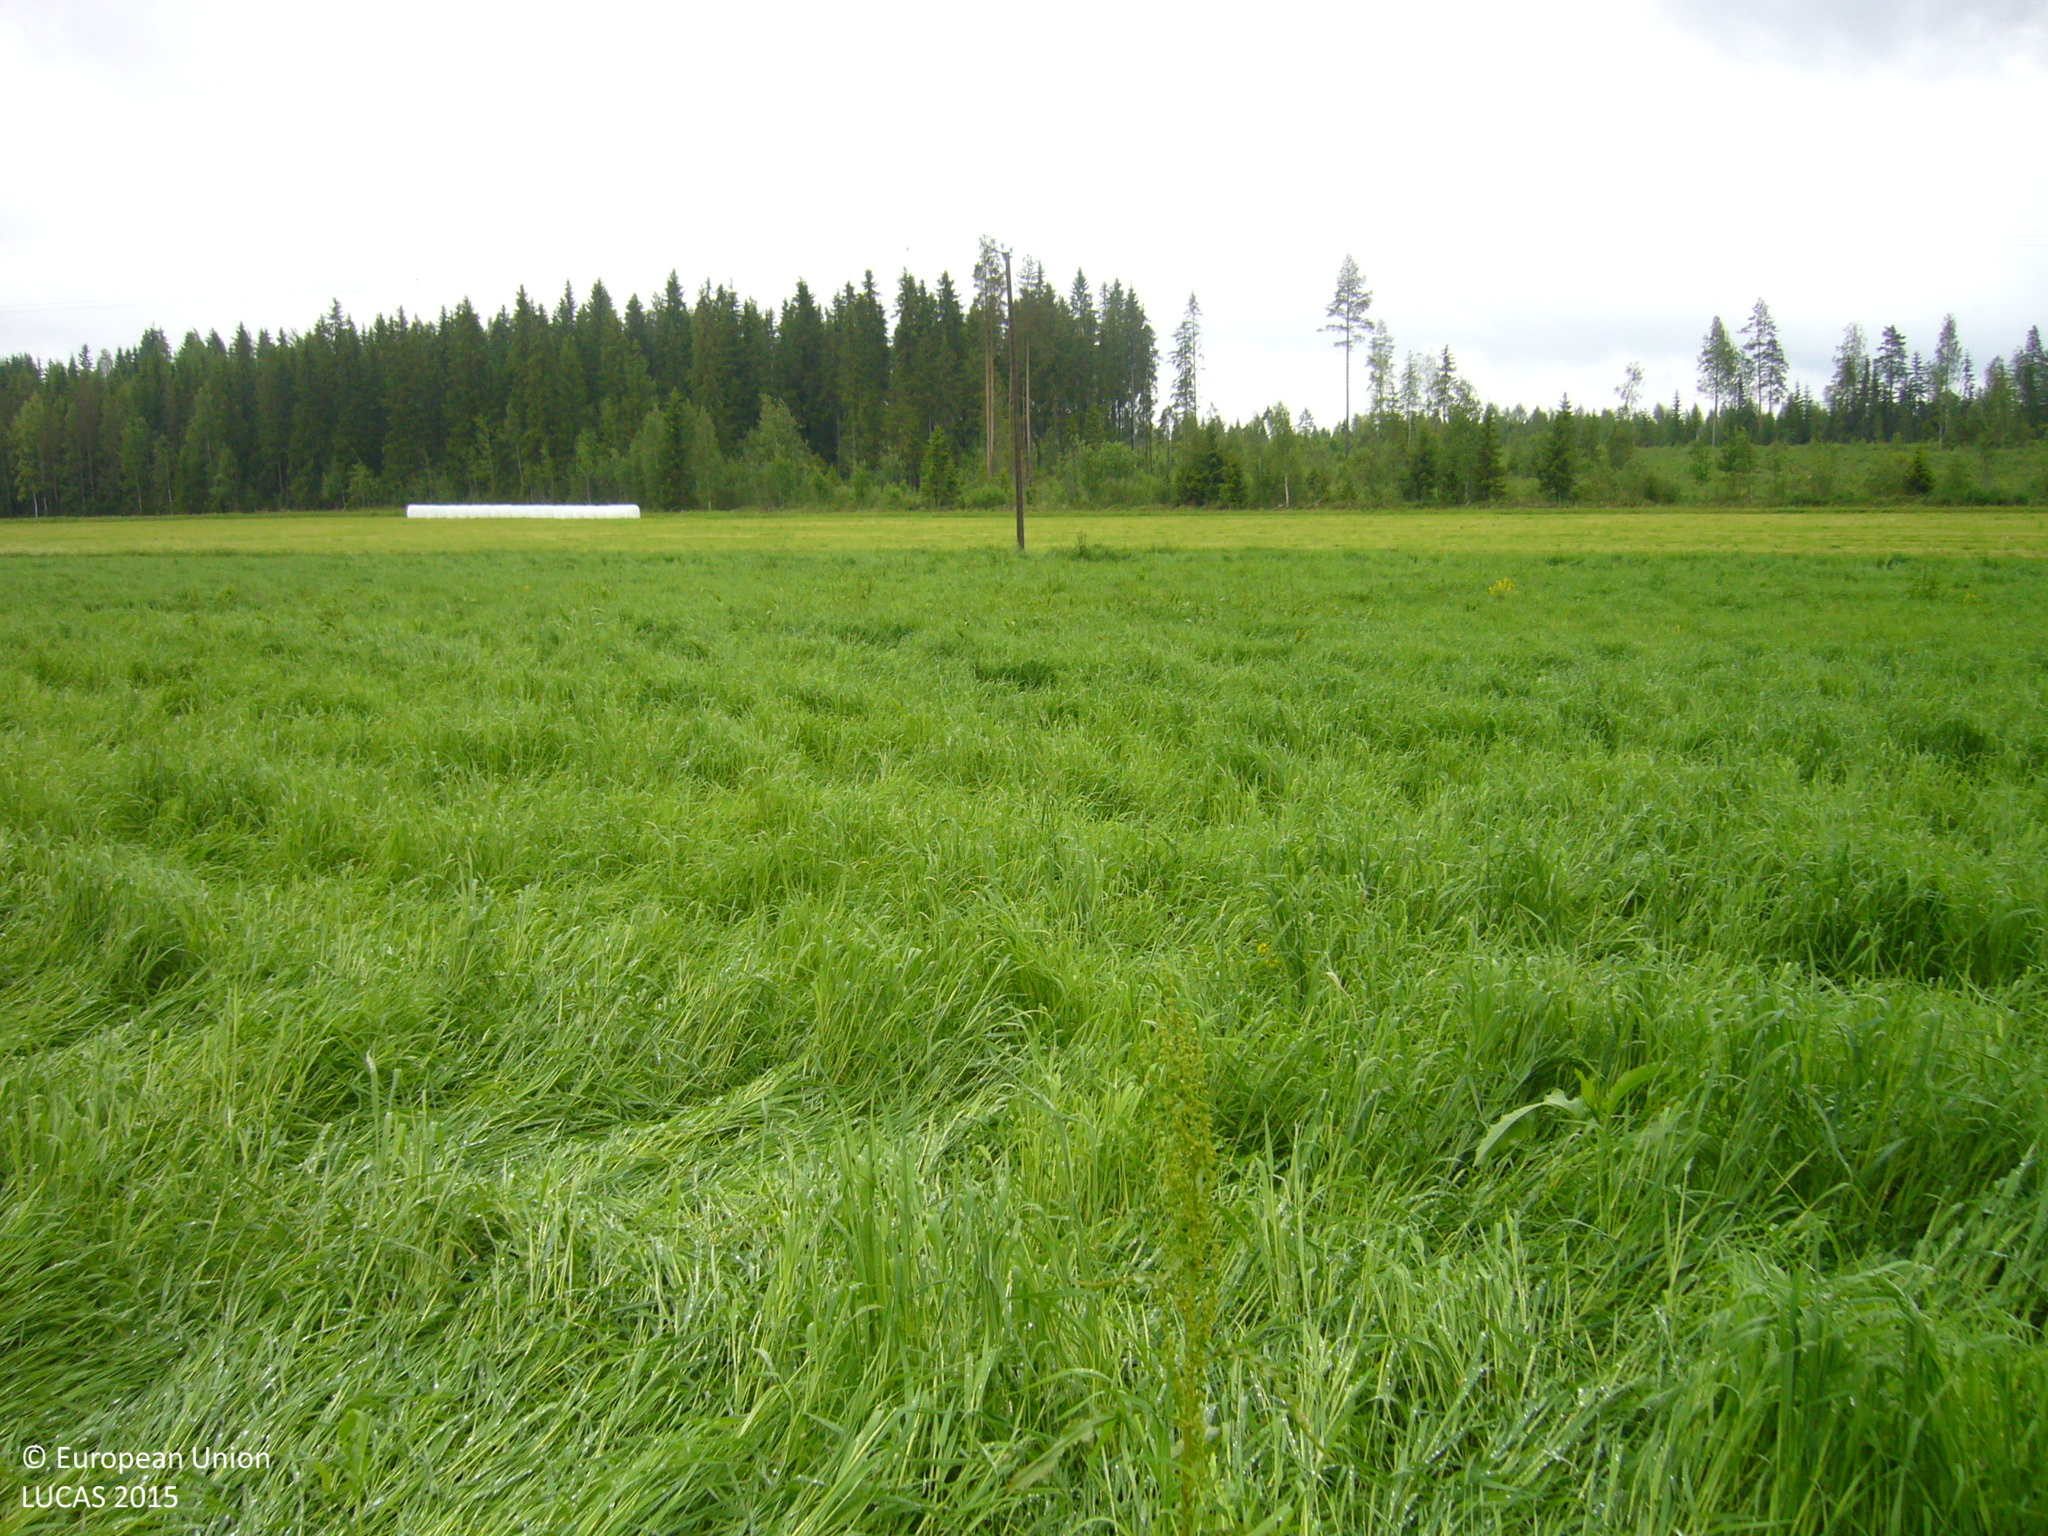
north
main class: Cropland
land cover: Temporary grasslands
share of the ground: > 75 %
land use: Agriculture (excluding fallow land and kitchen gardens)
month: June
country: FI
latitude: 63.6453
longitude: 26.4164
